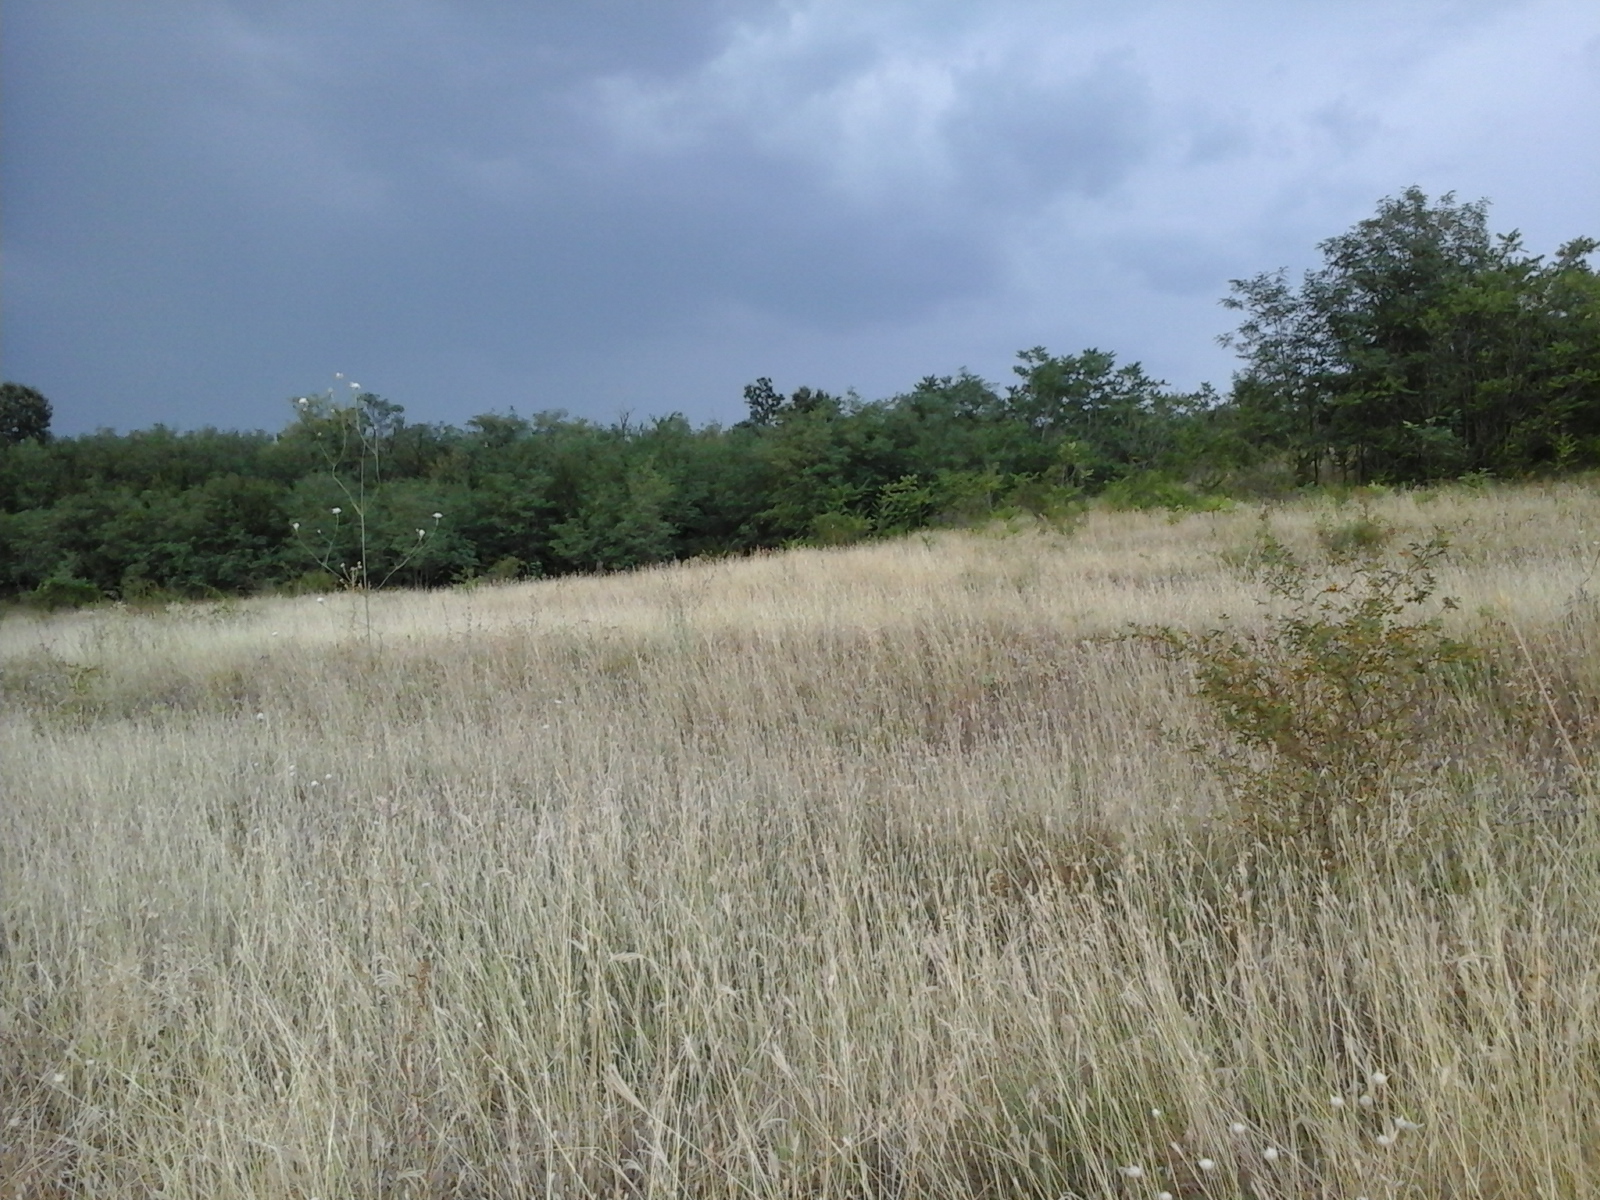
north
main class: Grassland
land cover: Grassland with sparse tree/shrub cover
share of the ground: > 75 %
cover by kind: herbaceous plants 90 %, broadleaved forest trees 5 %, shrubs 5 %
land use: Agriculture (excluding fallow land and kitchen gardens)
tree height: < 5 m
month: August
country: RO
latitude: 44.3181
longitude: 23.2504
